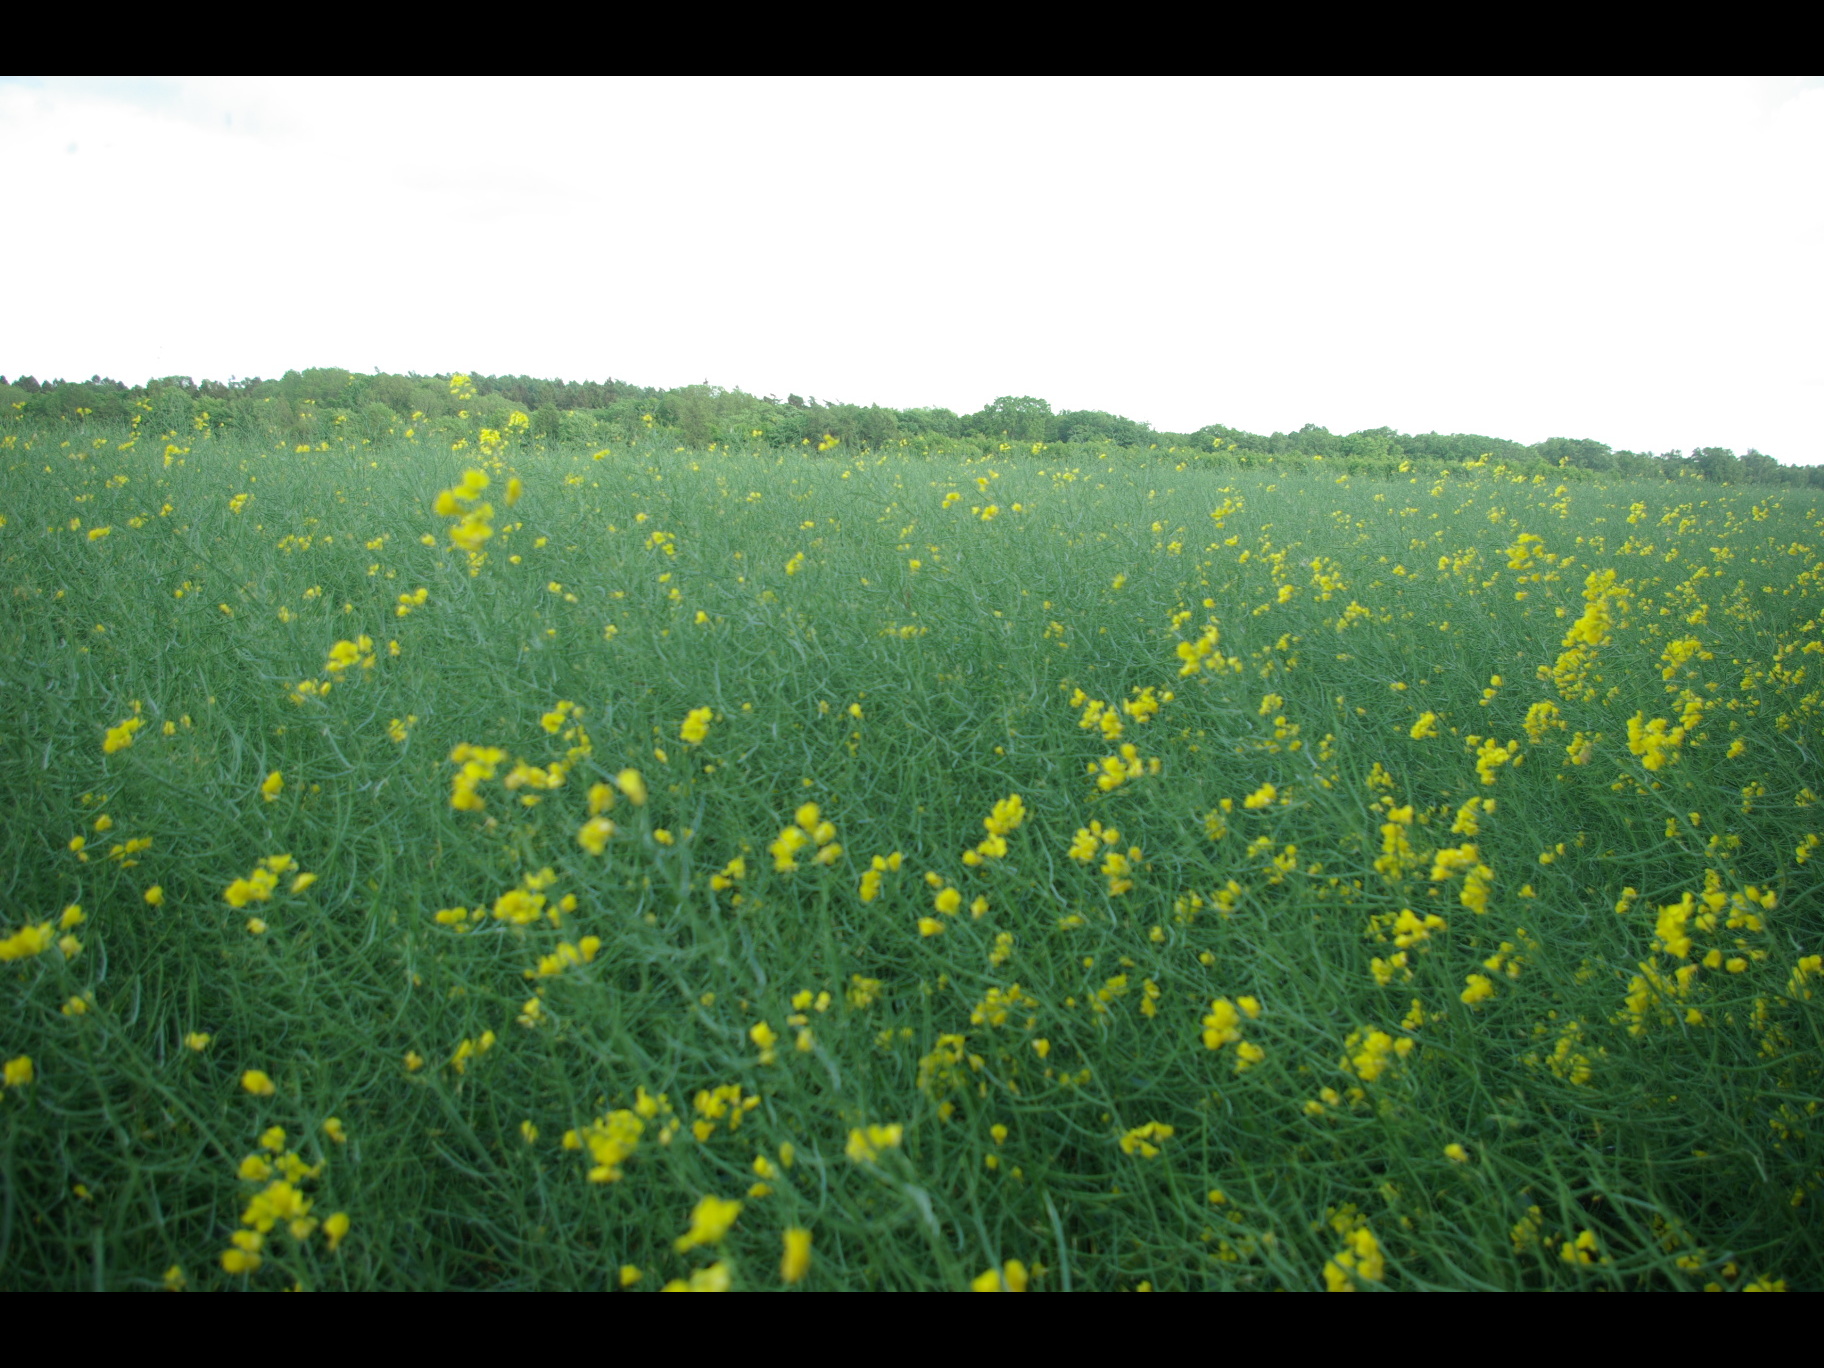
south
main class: Cropland
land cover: Rape and turnip rape
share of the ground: > 75 %
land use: Agriculture (excluding fallow land and kitchen gardens)
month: June
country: DE
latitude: 54.2809
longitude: 10.6293
